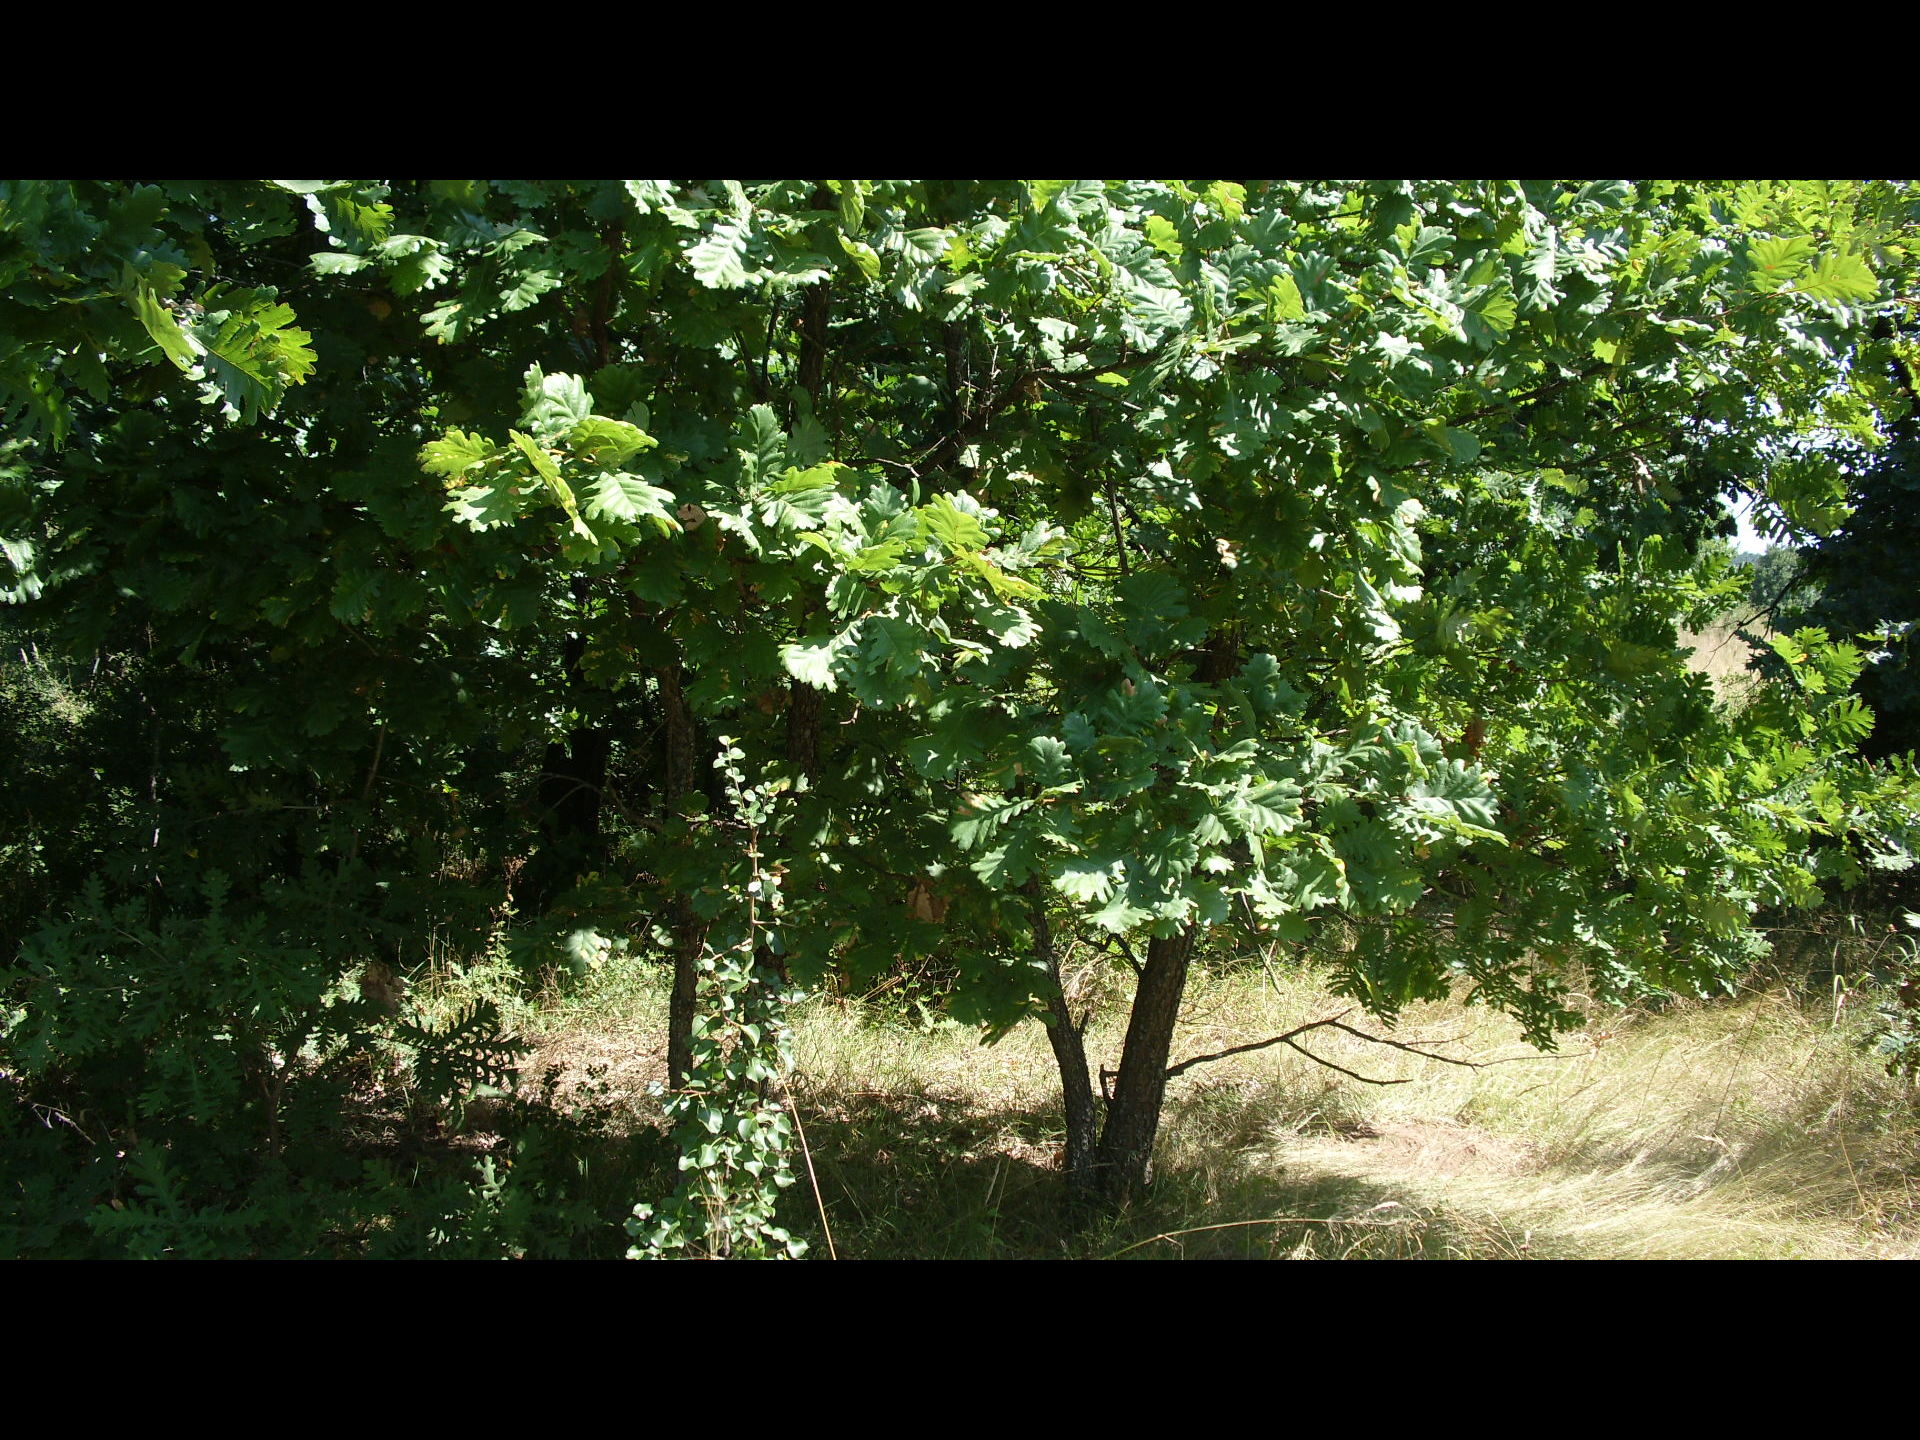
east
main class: Woodland
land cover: Broadleaved woodland
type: mesophytic deciduous forest
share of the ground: 50 - 75 %
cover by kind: broadleaved forest trees 60 %, herbaceous plants 30 %, shrubs 10 %
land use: Forestry
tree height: > 5 m
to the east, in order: Broadleaved woodland; Shrubland with sparse tree cover; Grassland with sparse tree/shrub cover; Other bare soil
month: August
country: BG
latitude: 43.5205
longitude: 23.0657
